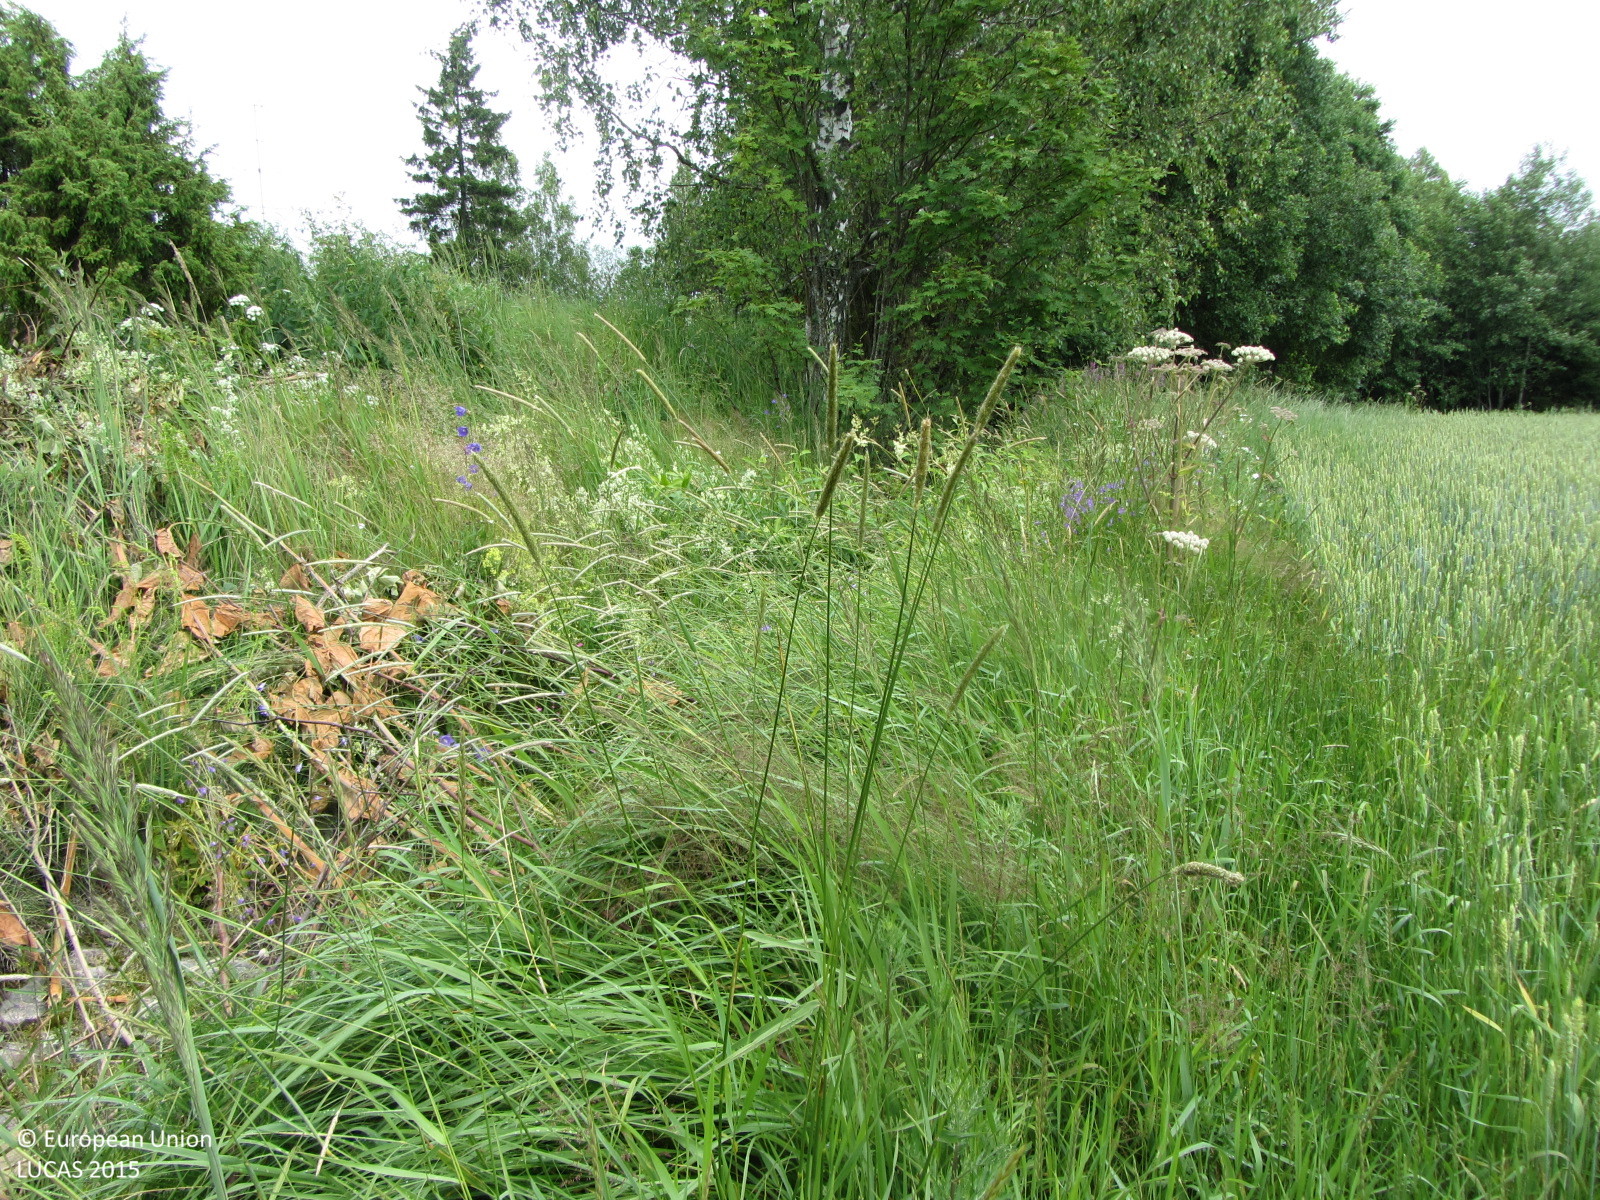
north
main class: Cropland
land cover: Common wheat
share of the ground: > 75 %
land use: Agriculture (excluding fallow land and kitchen gardens)
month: July
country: FI
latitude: 60.0583
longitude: 24.0566
